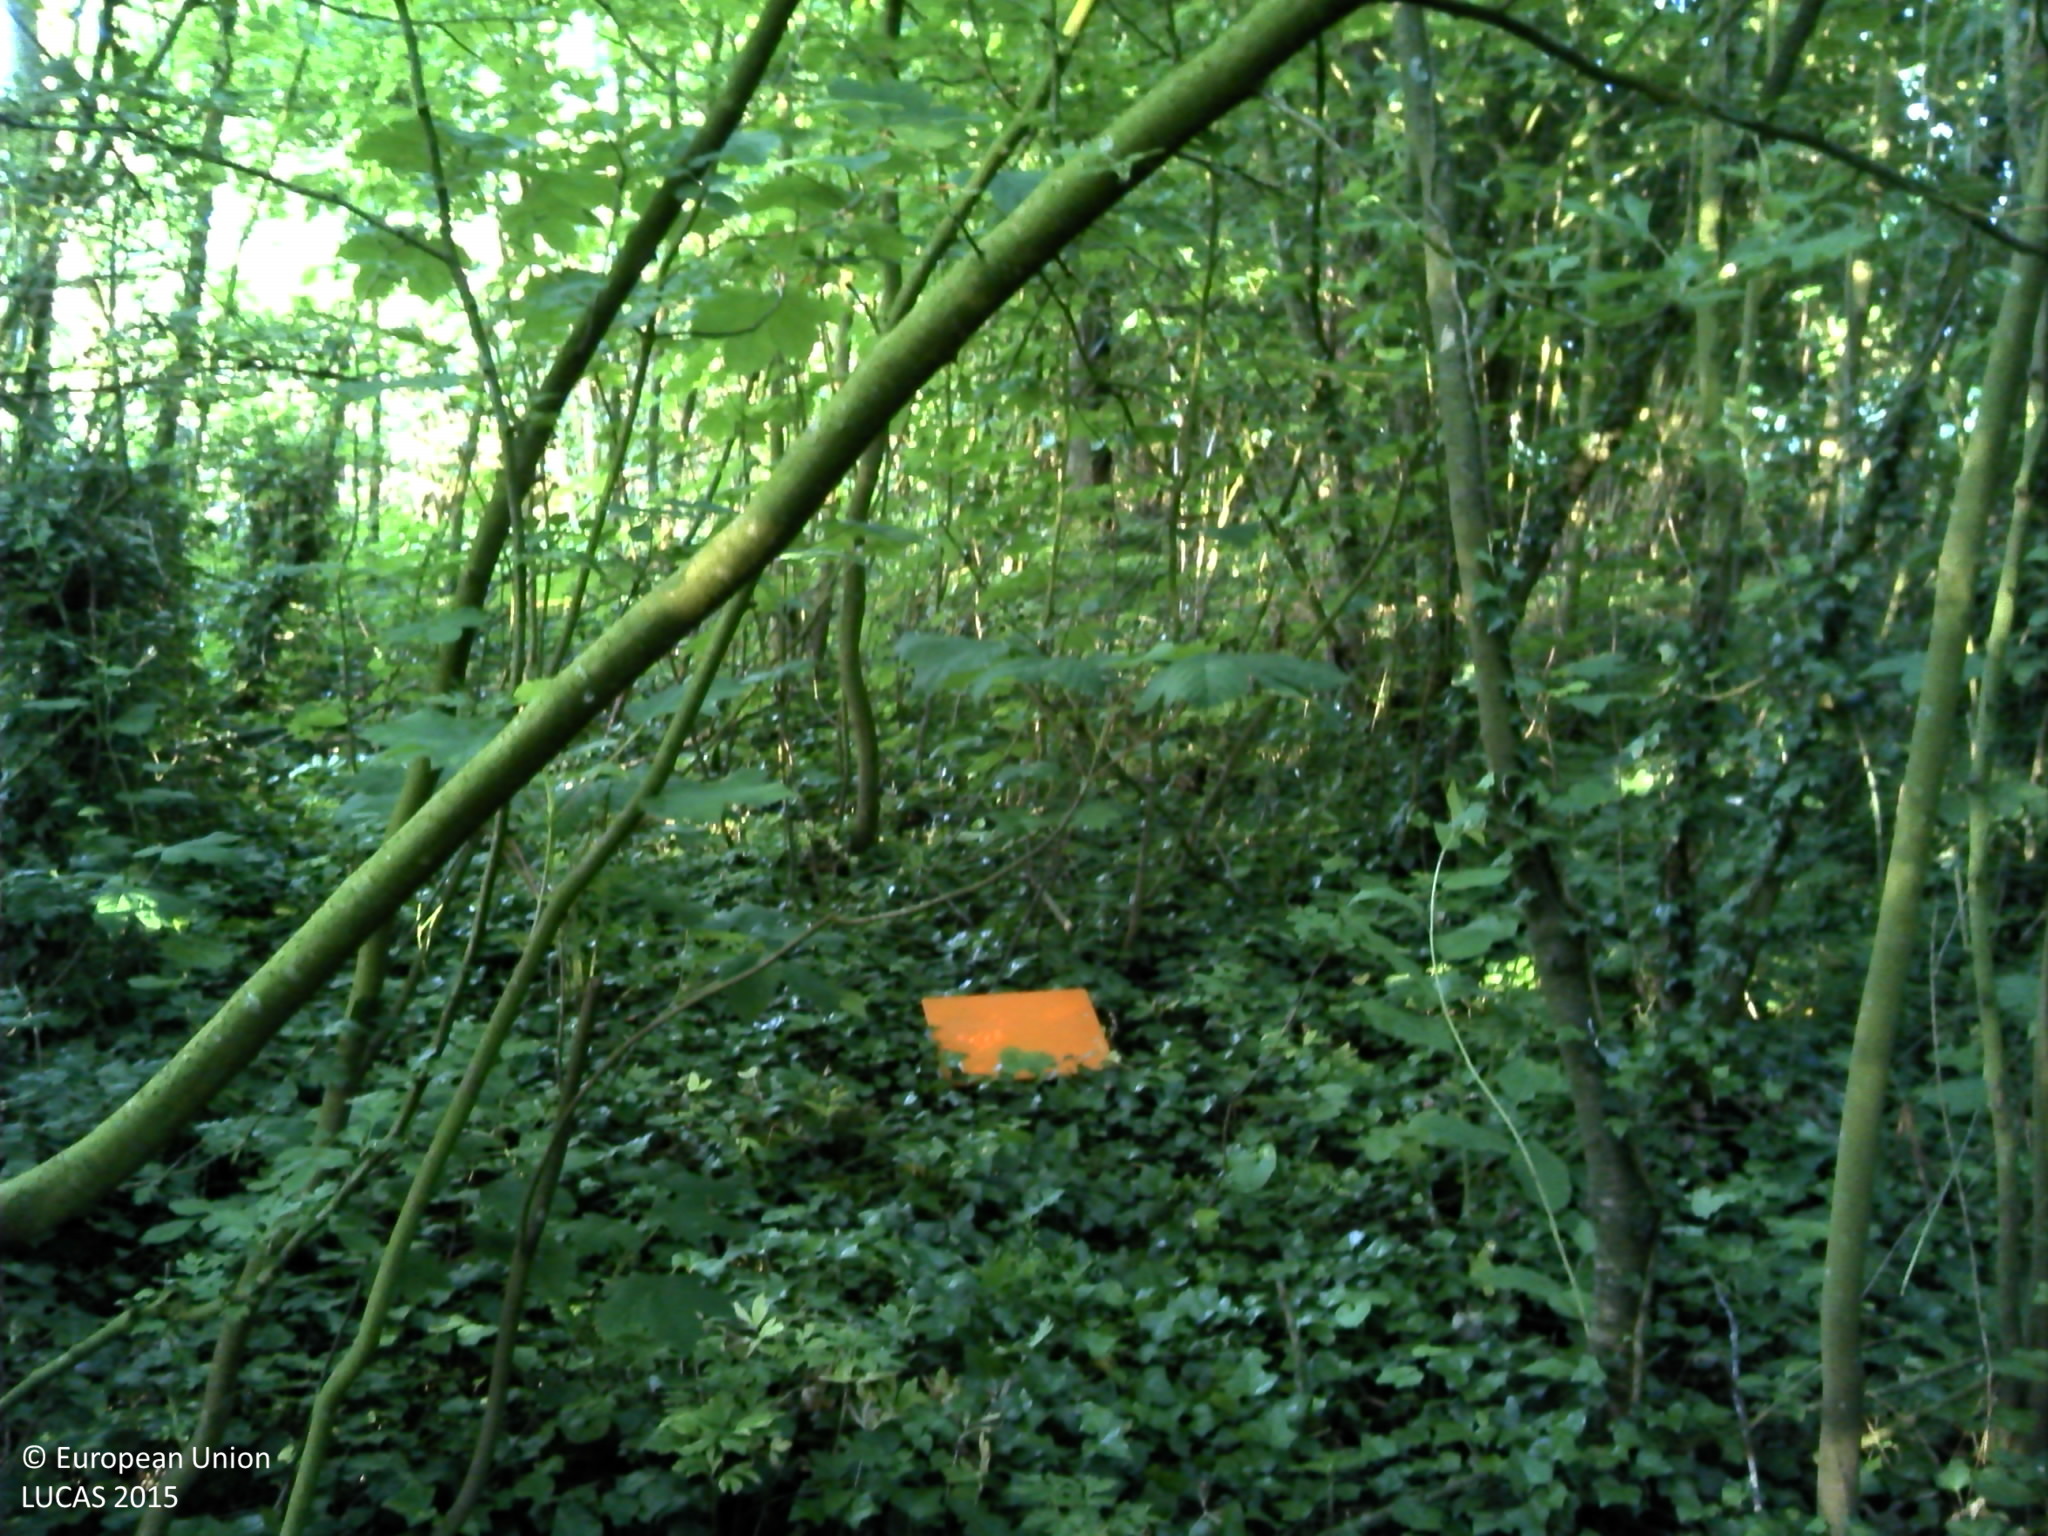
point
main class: Woodland
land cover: Broadleaved woodland
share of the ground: > 75 %
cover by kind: broadleaved forest trees 80 %, herbaceous plants 20 %
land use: Forestry
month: June
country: FR
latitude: 49.6746
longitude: 1.1235
